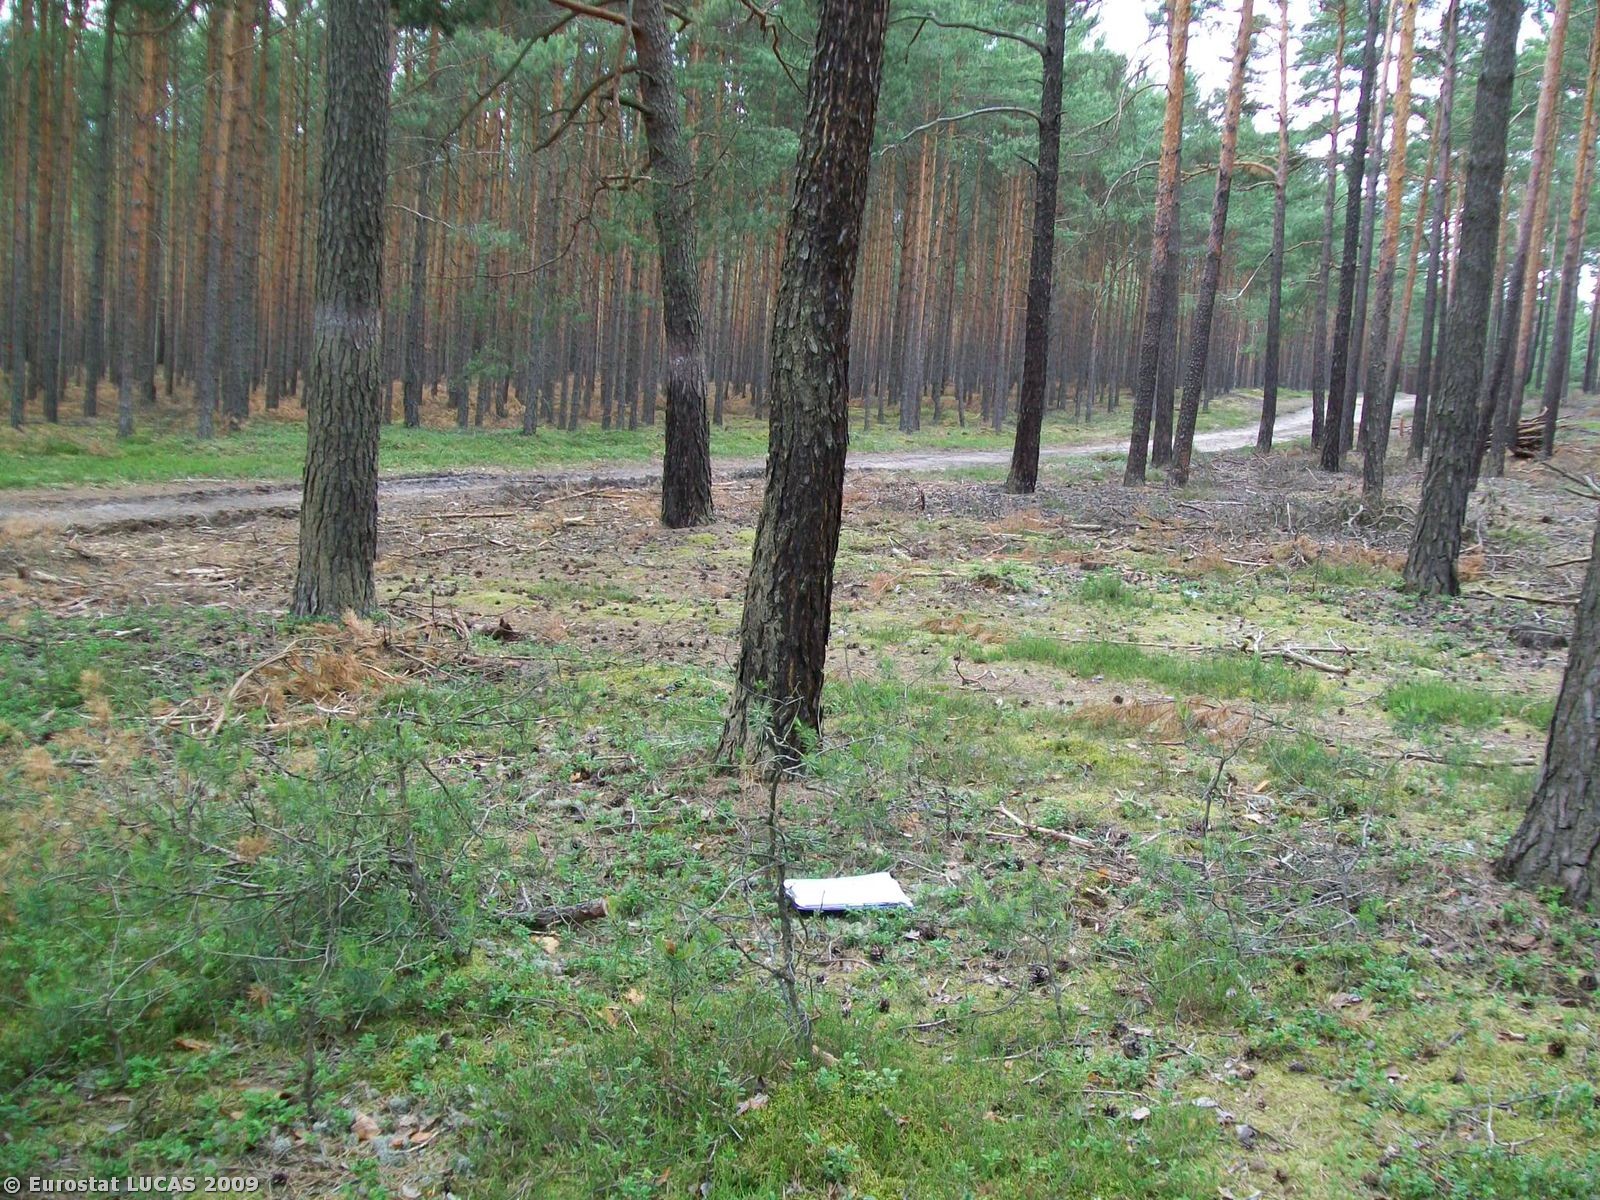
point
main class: Woodland
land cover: Coniferous woodland
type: hemiboreal forest and nemoral coniferous forest and mixed broadleaved-coniferous forest
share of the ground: > 75 %
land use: Forestry
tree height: > 5 m
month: June
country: PL
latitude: 51.8512
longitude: 15.1570
